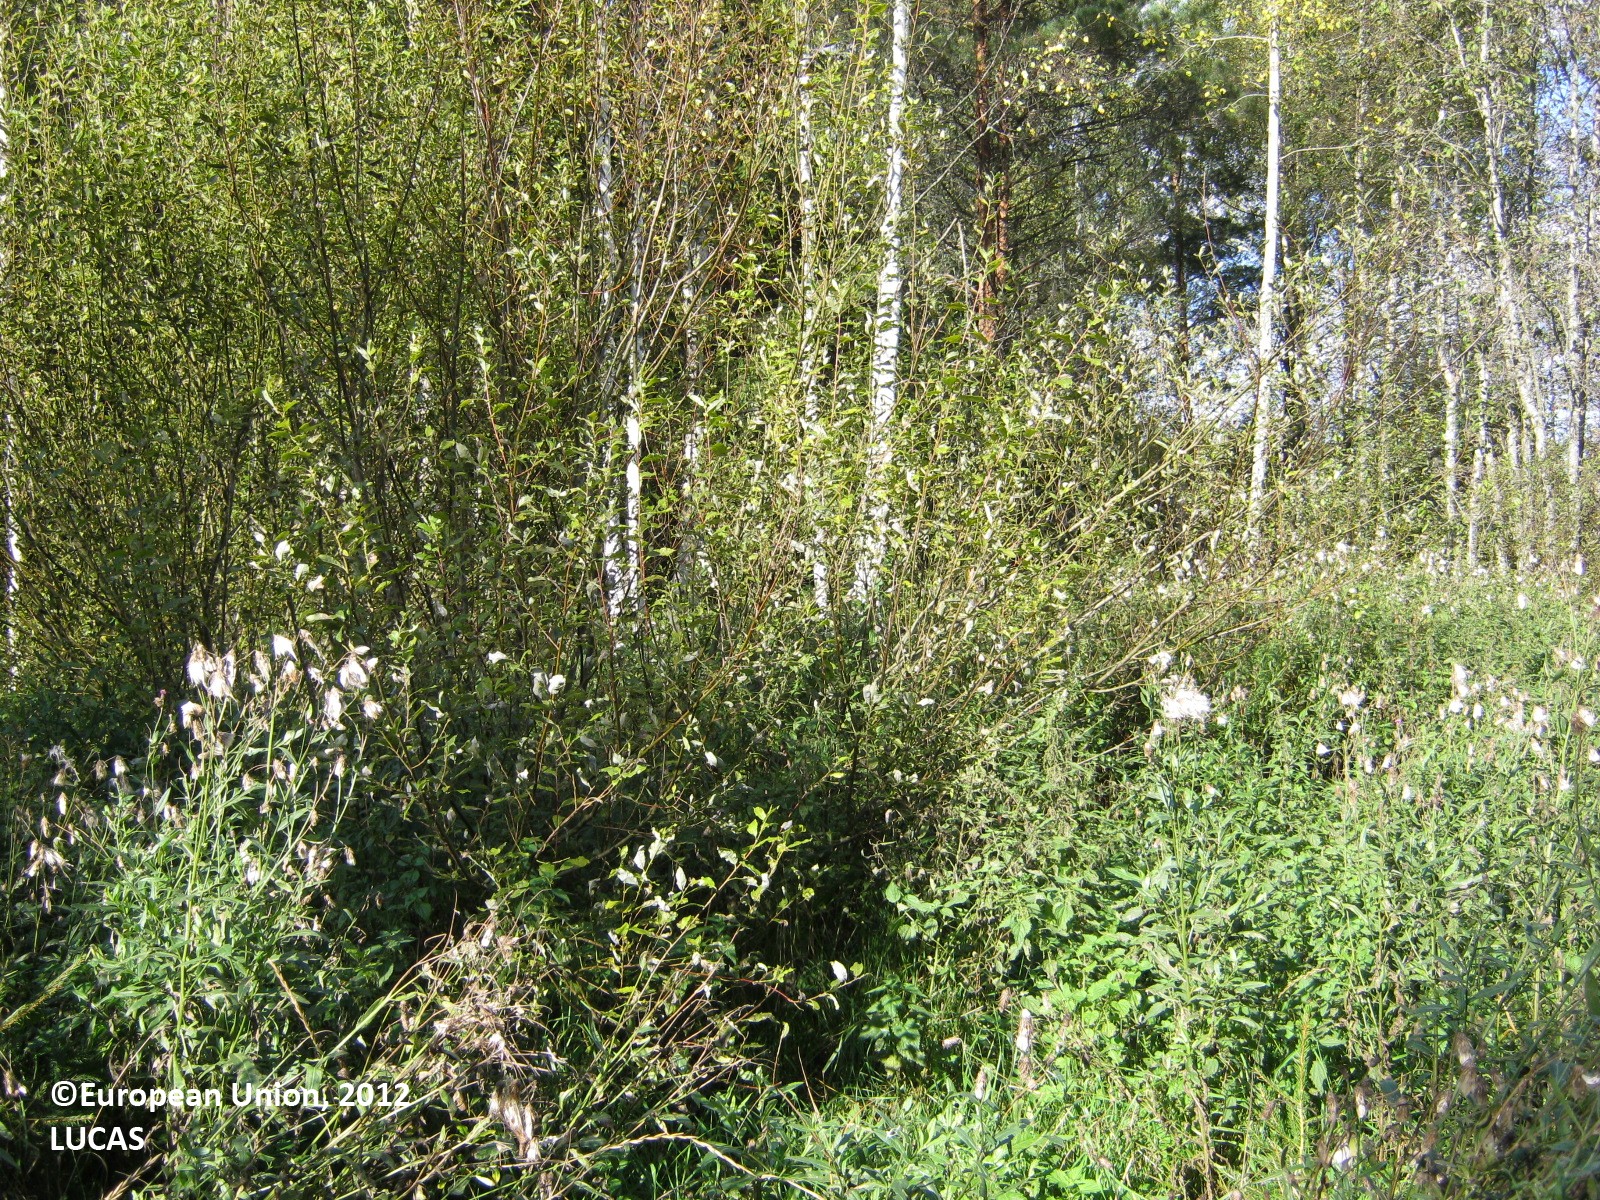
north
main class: Shrubland
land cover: Shrubland with sparse tree cover
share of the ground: > 75 %
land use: Semi-natural and natural areas not in use
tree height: < 5 m
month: September
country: FI
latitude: 60.8932
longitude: 27.7544
